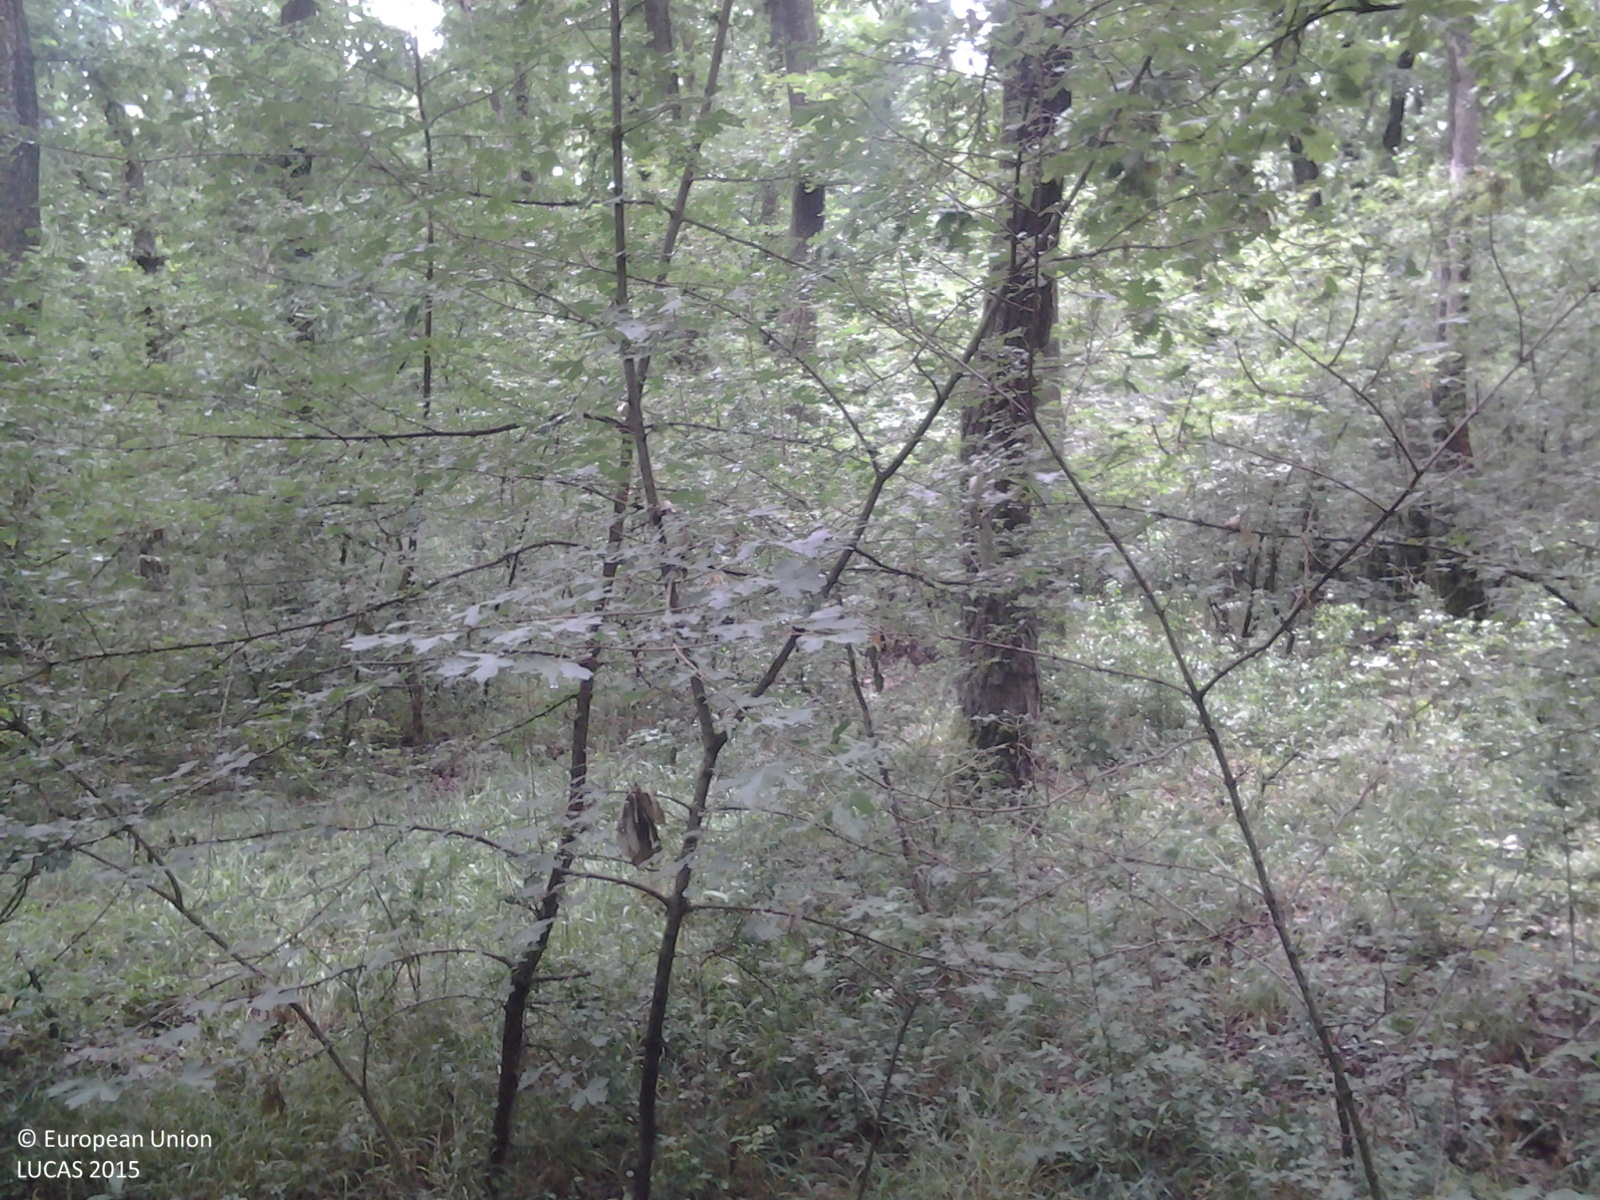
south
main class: Woodland
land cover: Broadleaved woodland
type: mesophytic deciduous forest
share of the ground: > 75 %
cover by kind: broadleaved forest trees 85 %, shrubs 10 %, herbaceous plants 5 %
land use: Forestry
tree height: > 5 m
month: June
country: HU
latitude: 46.9030
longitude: 17.2119
